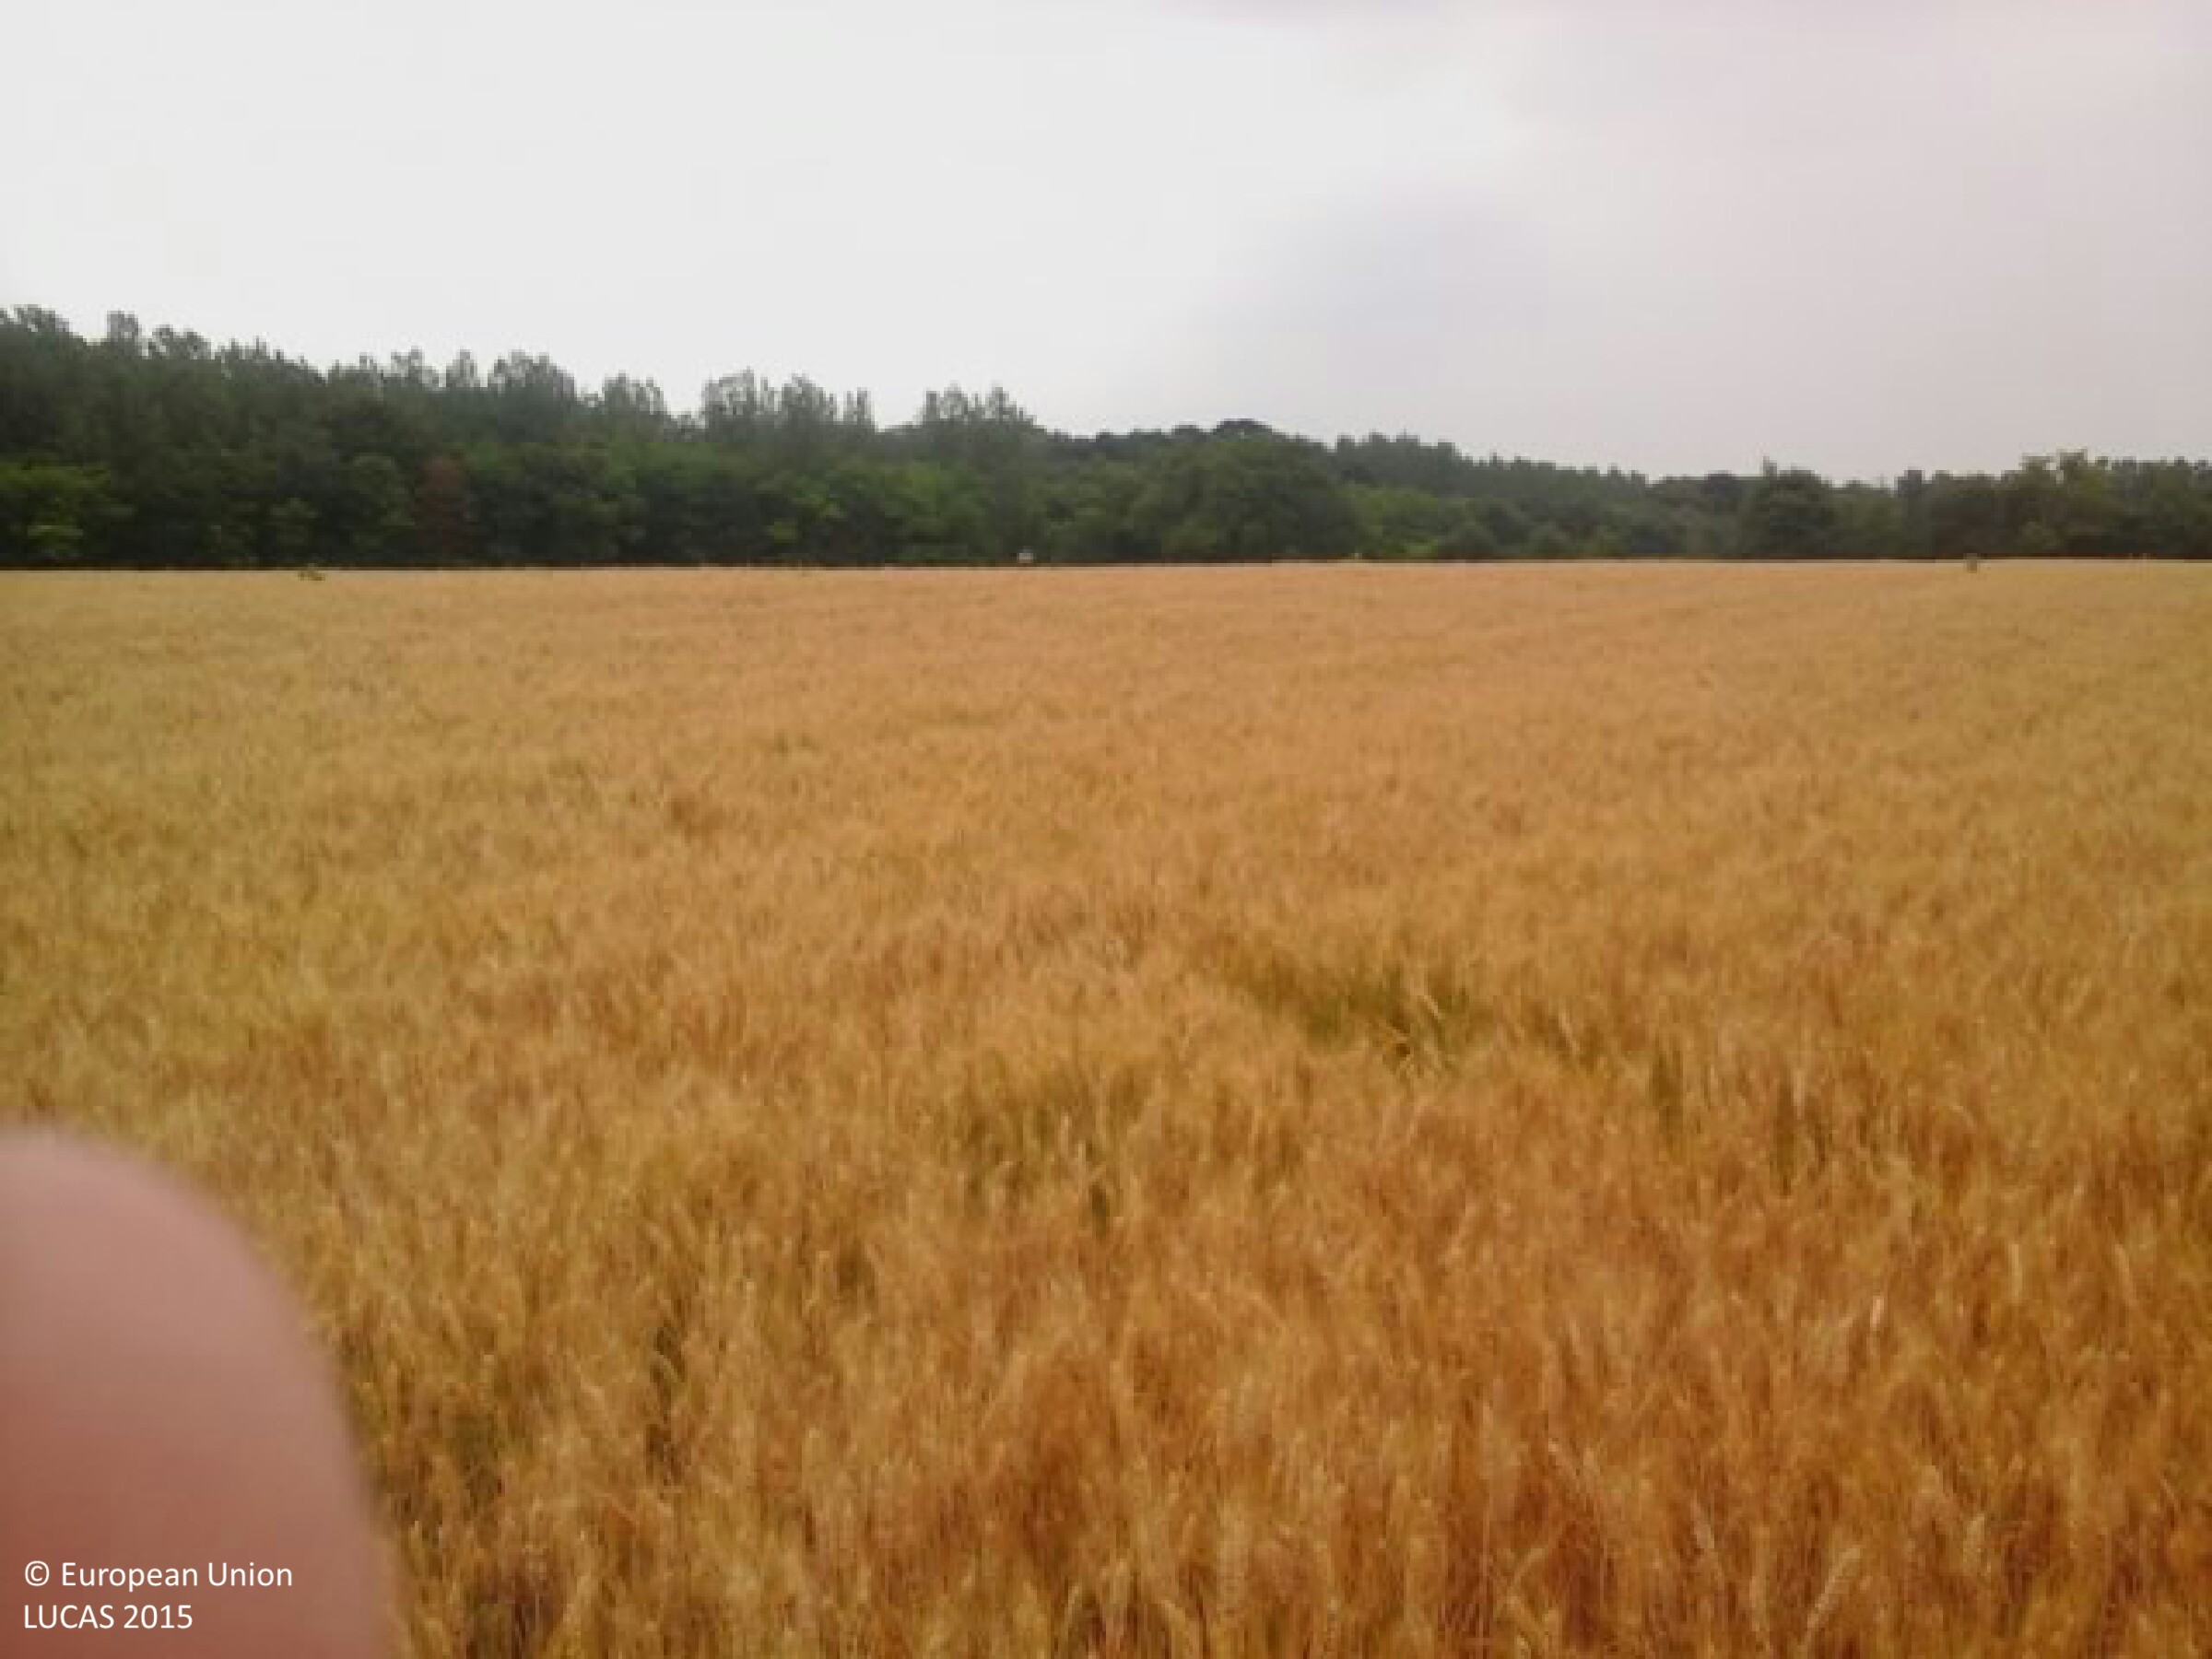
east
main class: Cropland
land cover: Common wheat
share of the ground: > 75 %
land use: Agriculture (excluding fallow land and kitchen gardens)
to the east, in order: Common wheat; Grass margins; Broadleaved woodland
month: June
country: HU
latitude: 46.3409
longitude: 18.9122
